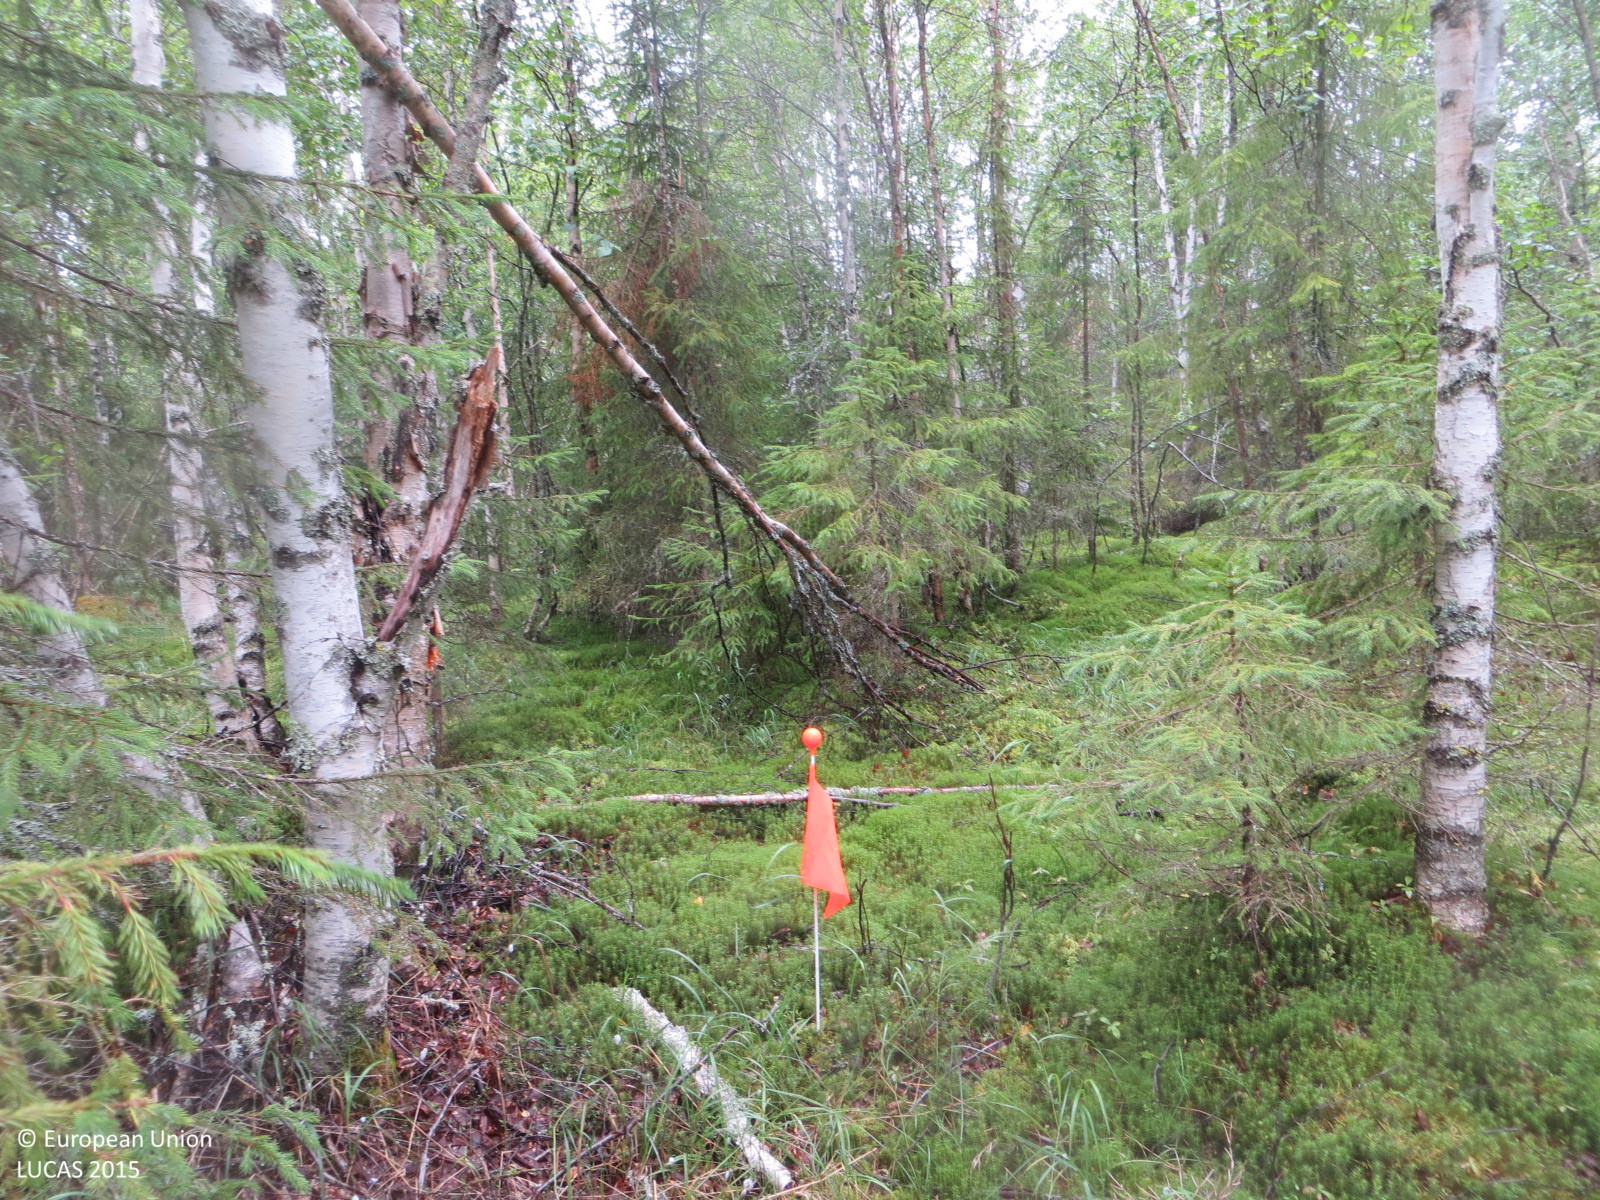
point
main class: Woodland
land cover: Spruce dominated mixed woodland
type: boreal forest
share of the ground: 50 - 75 %
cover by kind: broadleaved forest trees 40 %, coniferous forest trees 30 %, lichens and mosses 30 %
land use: Forestry
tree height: > 5 m
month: July
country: FI
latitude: 65.9832
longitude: 24.6526
